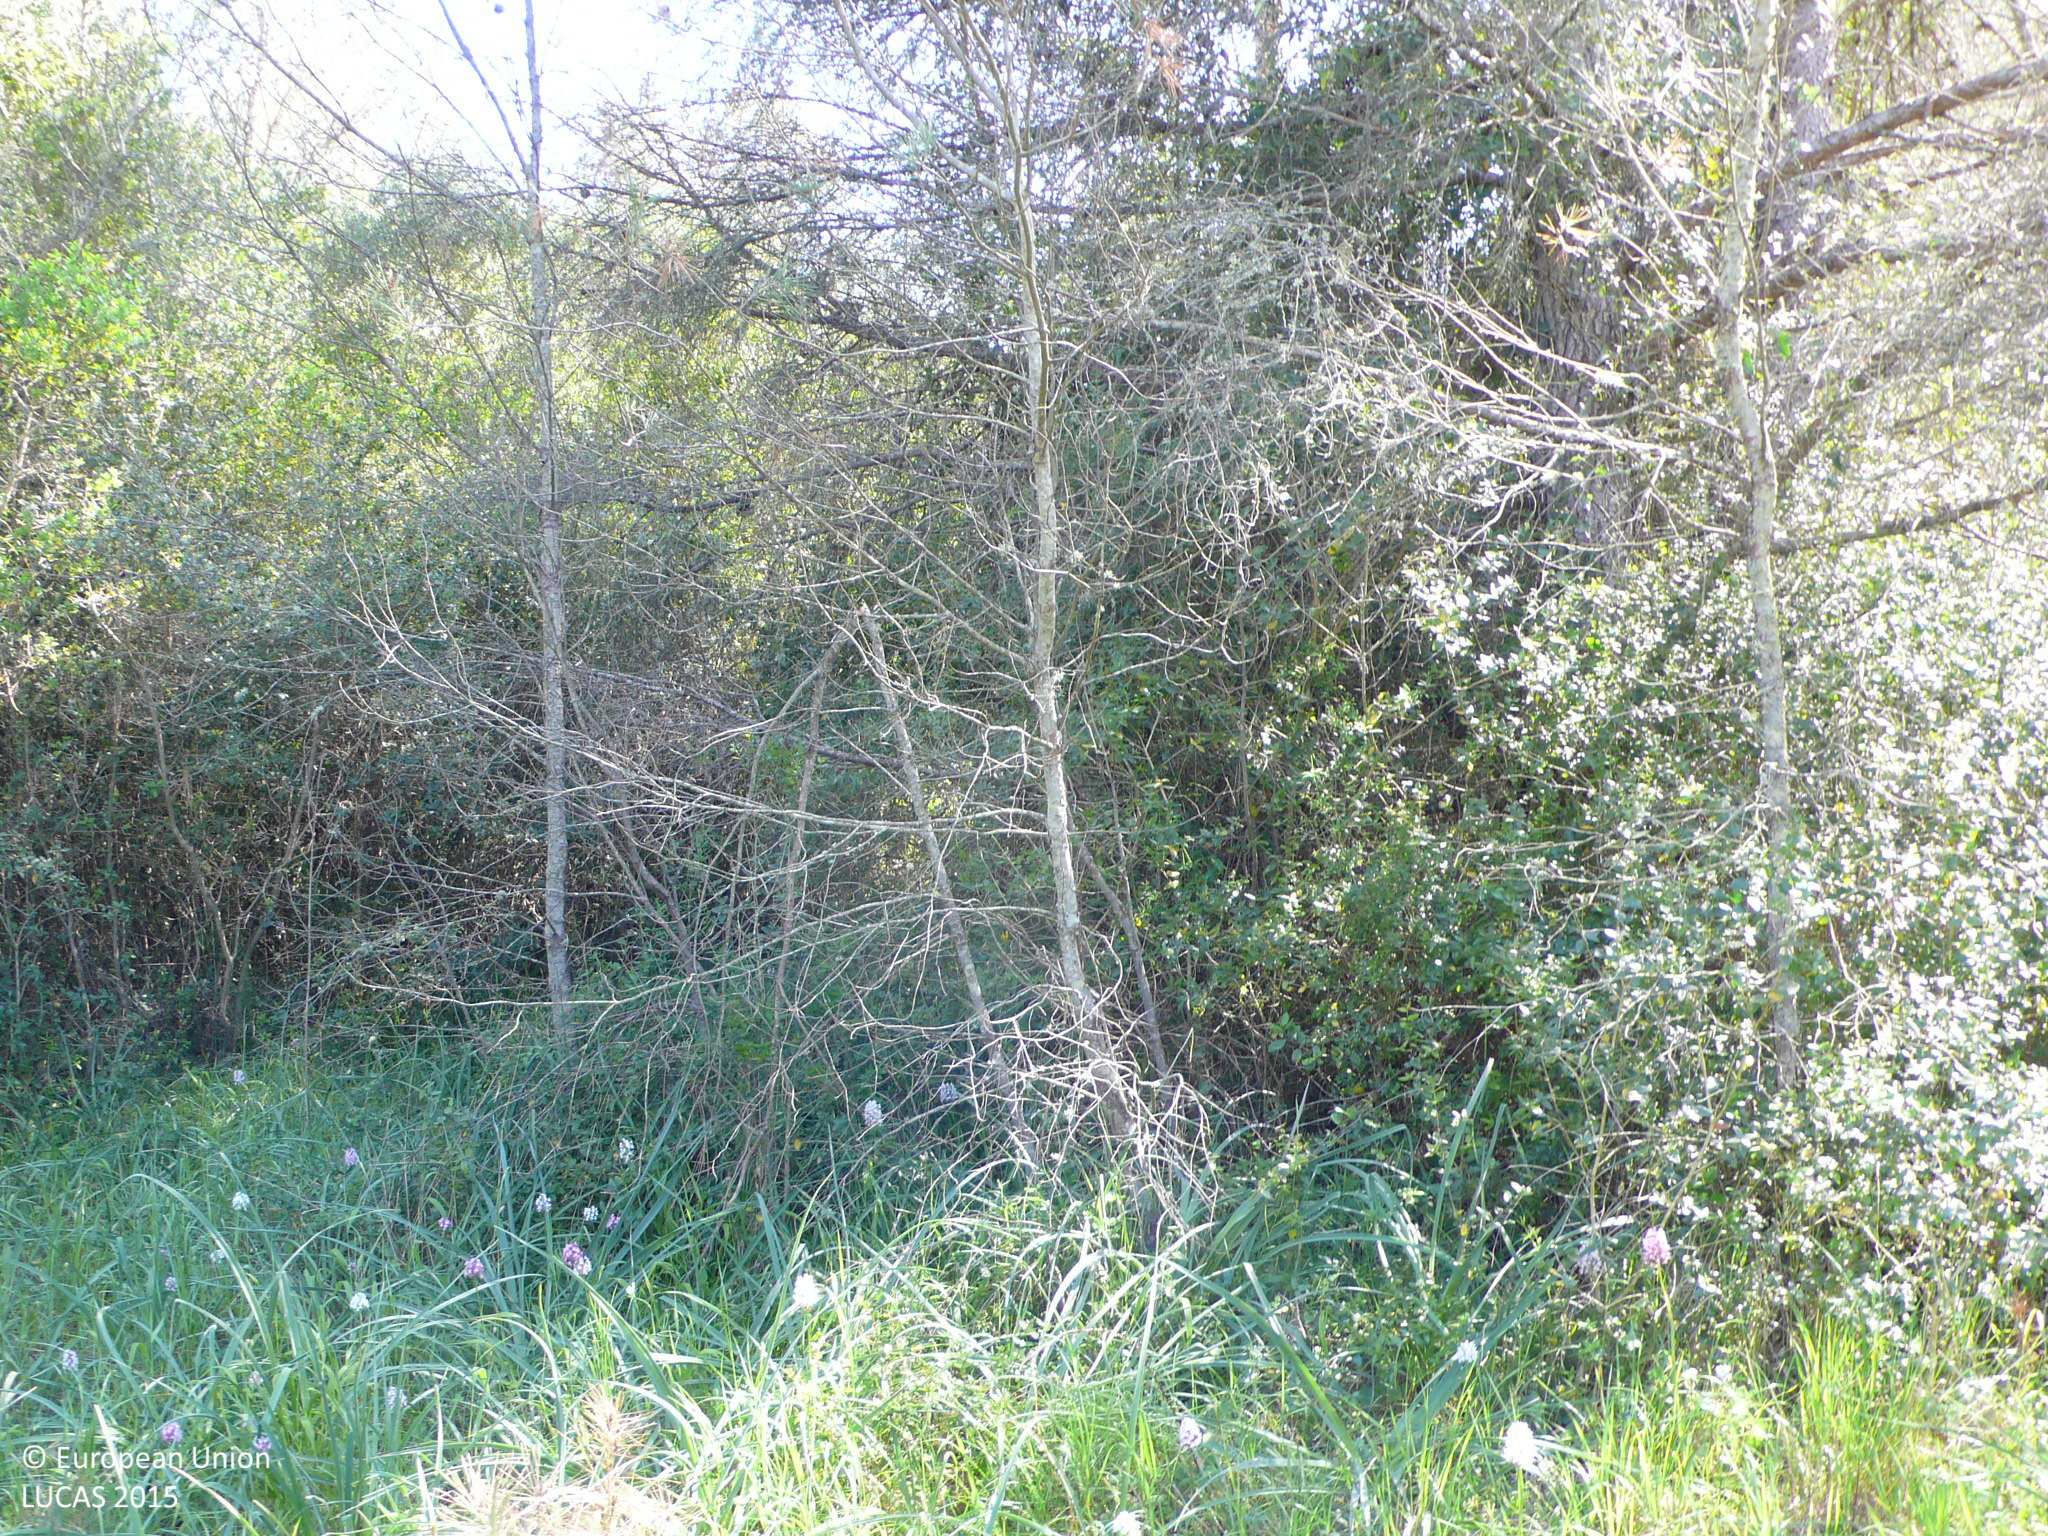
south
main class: Woodland
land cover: Other mixed woodland
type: coniferous forest of the mediterranean region
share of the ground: > 75 %
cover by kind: coniferous forest trees 50 %, broadleaved forest trees 45 %, shrubs 5 %
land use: Semi-natural and natural areas not in use
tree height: > 5 m
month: May
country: ES
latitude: 39.9260
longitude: 4.0940
